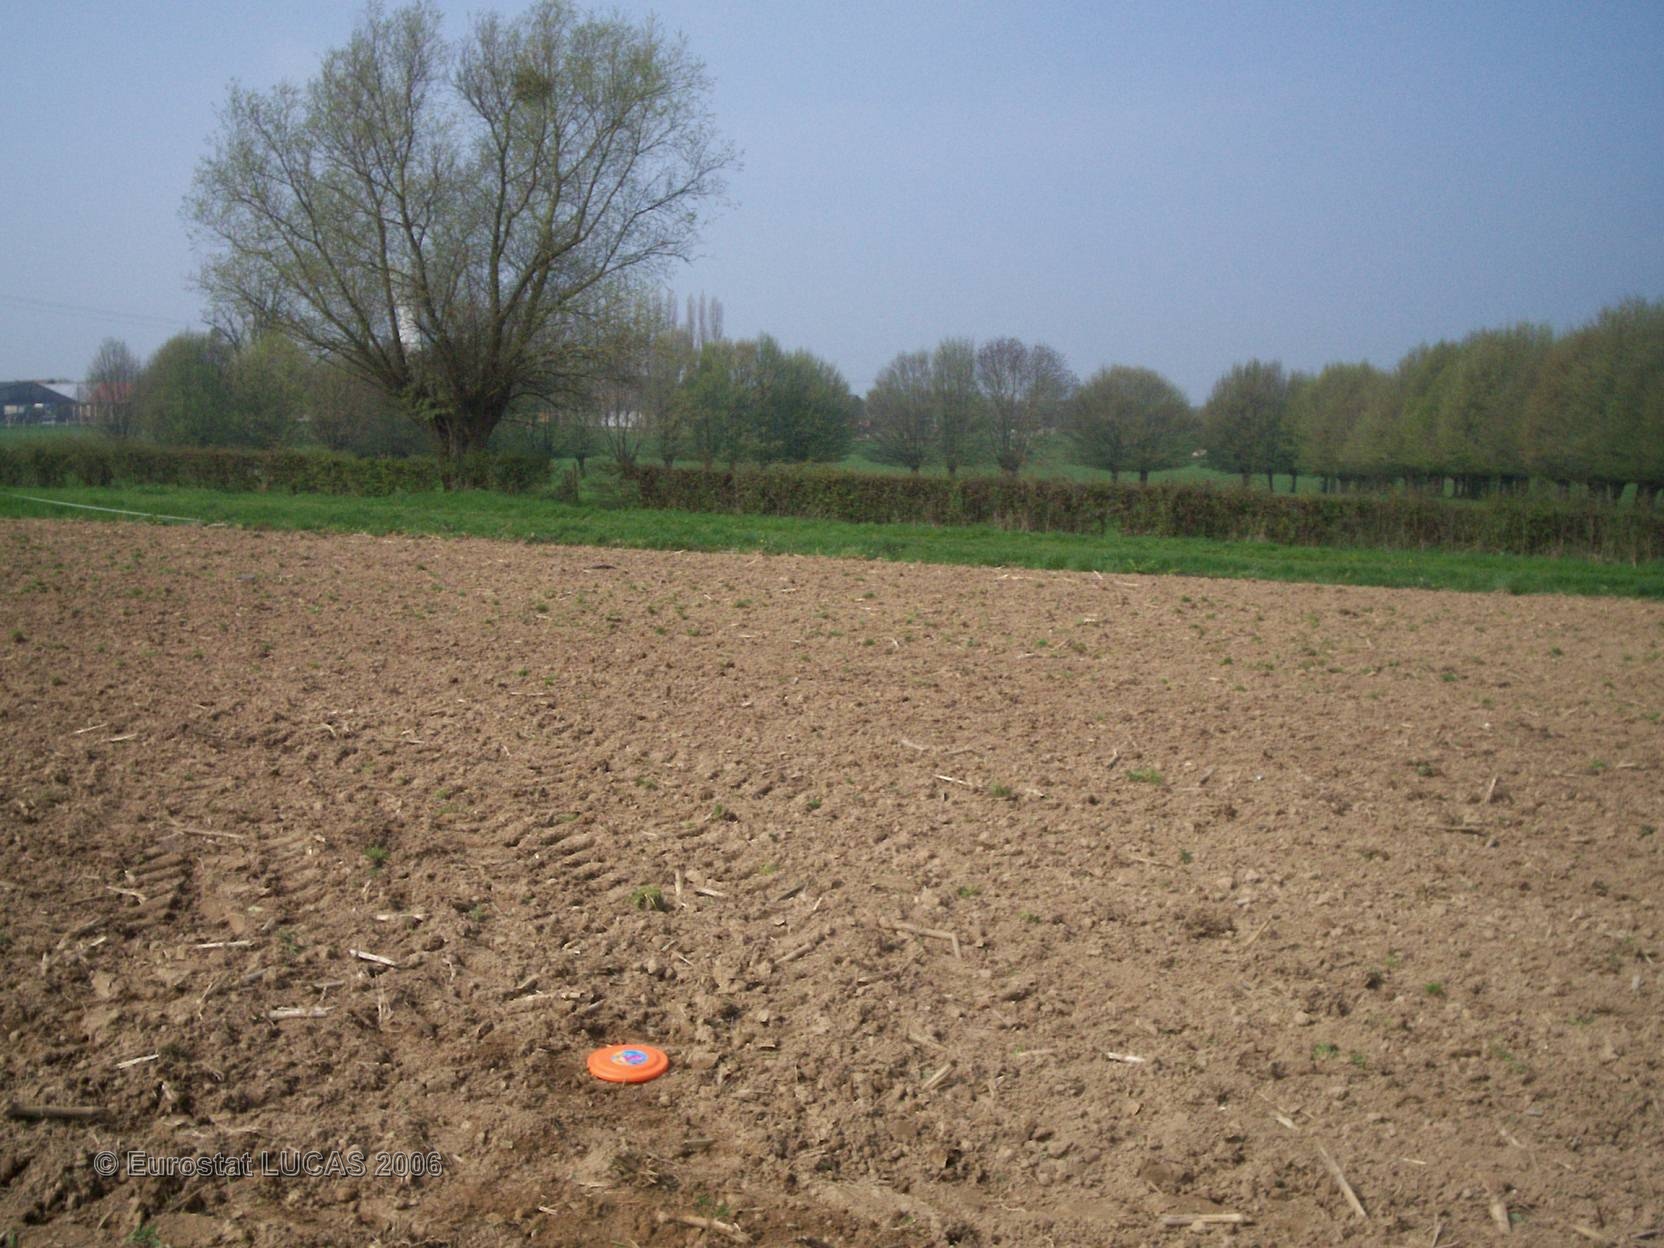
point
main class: Grassland
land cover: Grassland without tree/shrub cover
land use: Agriculture (excluding fallow land and kitchen gardens)
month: May
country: FR
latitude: 49.9937
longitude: 3.7302
